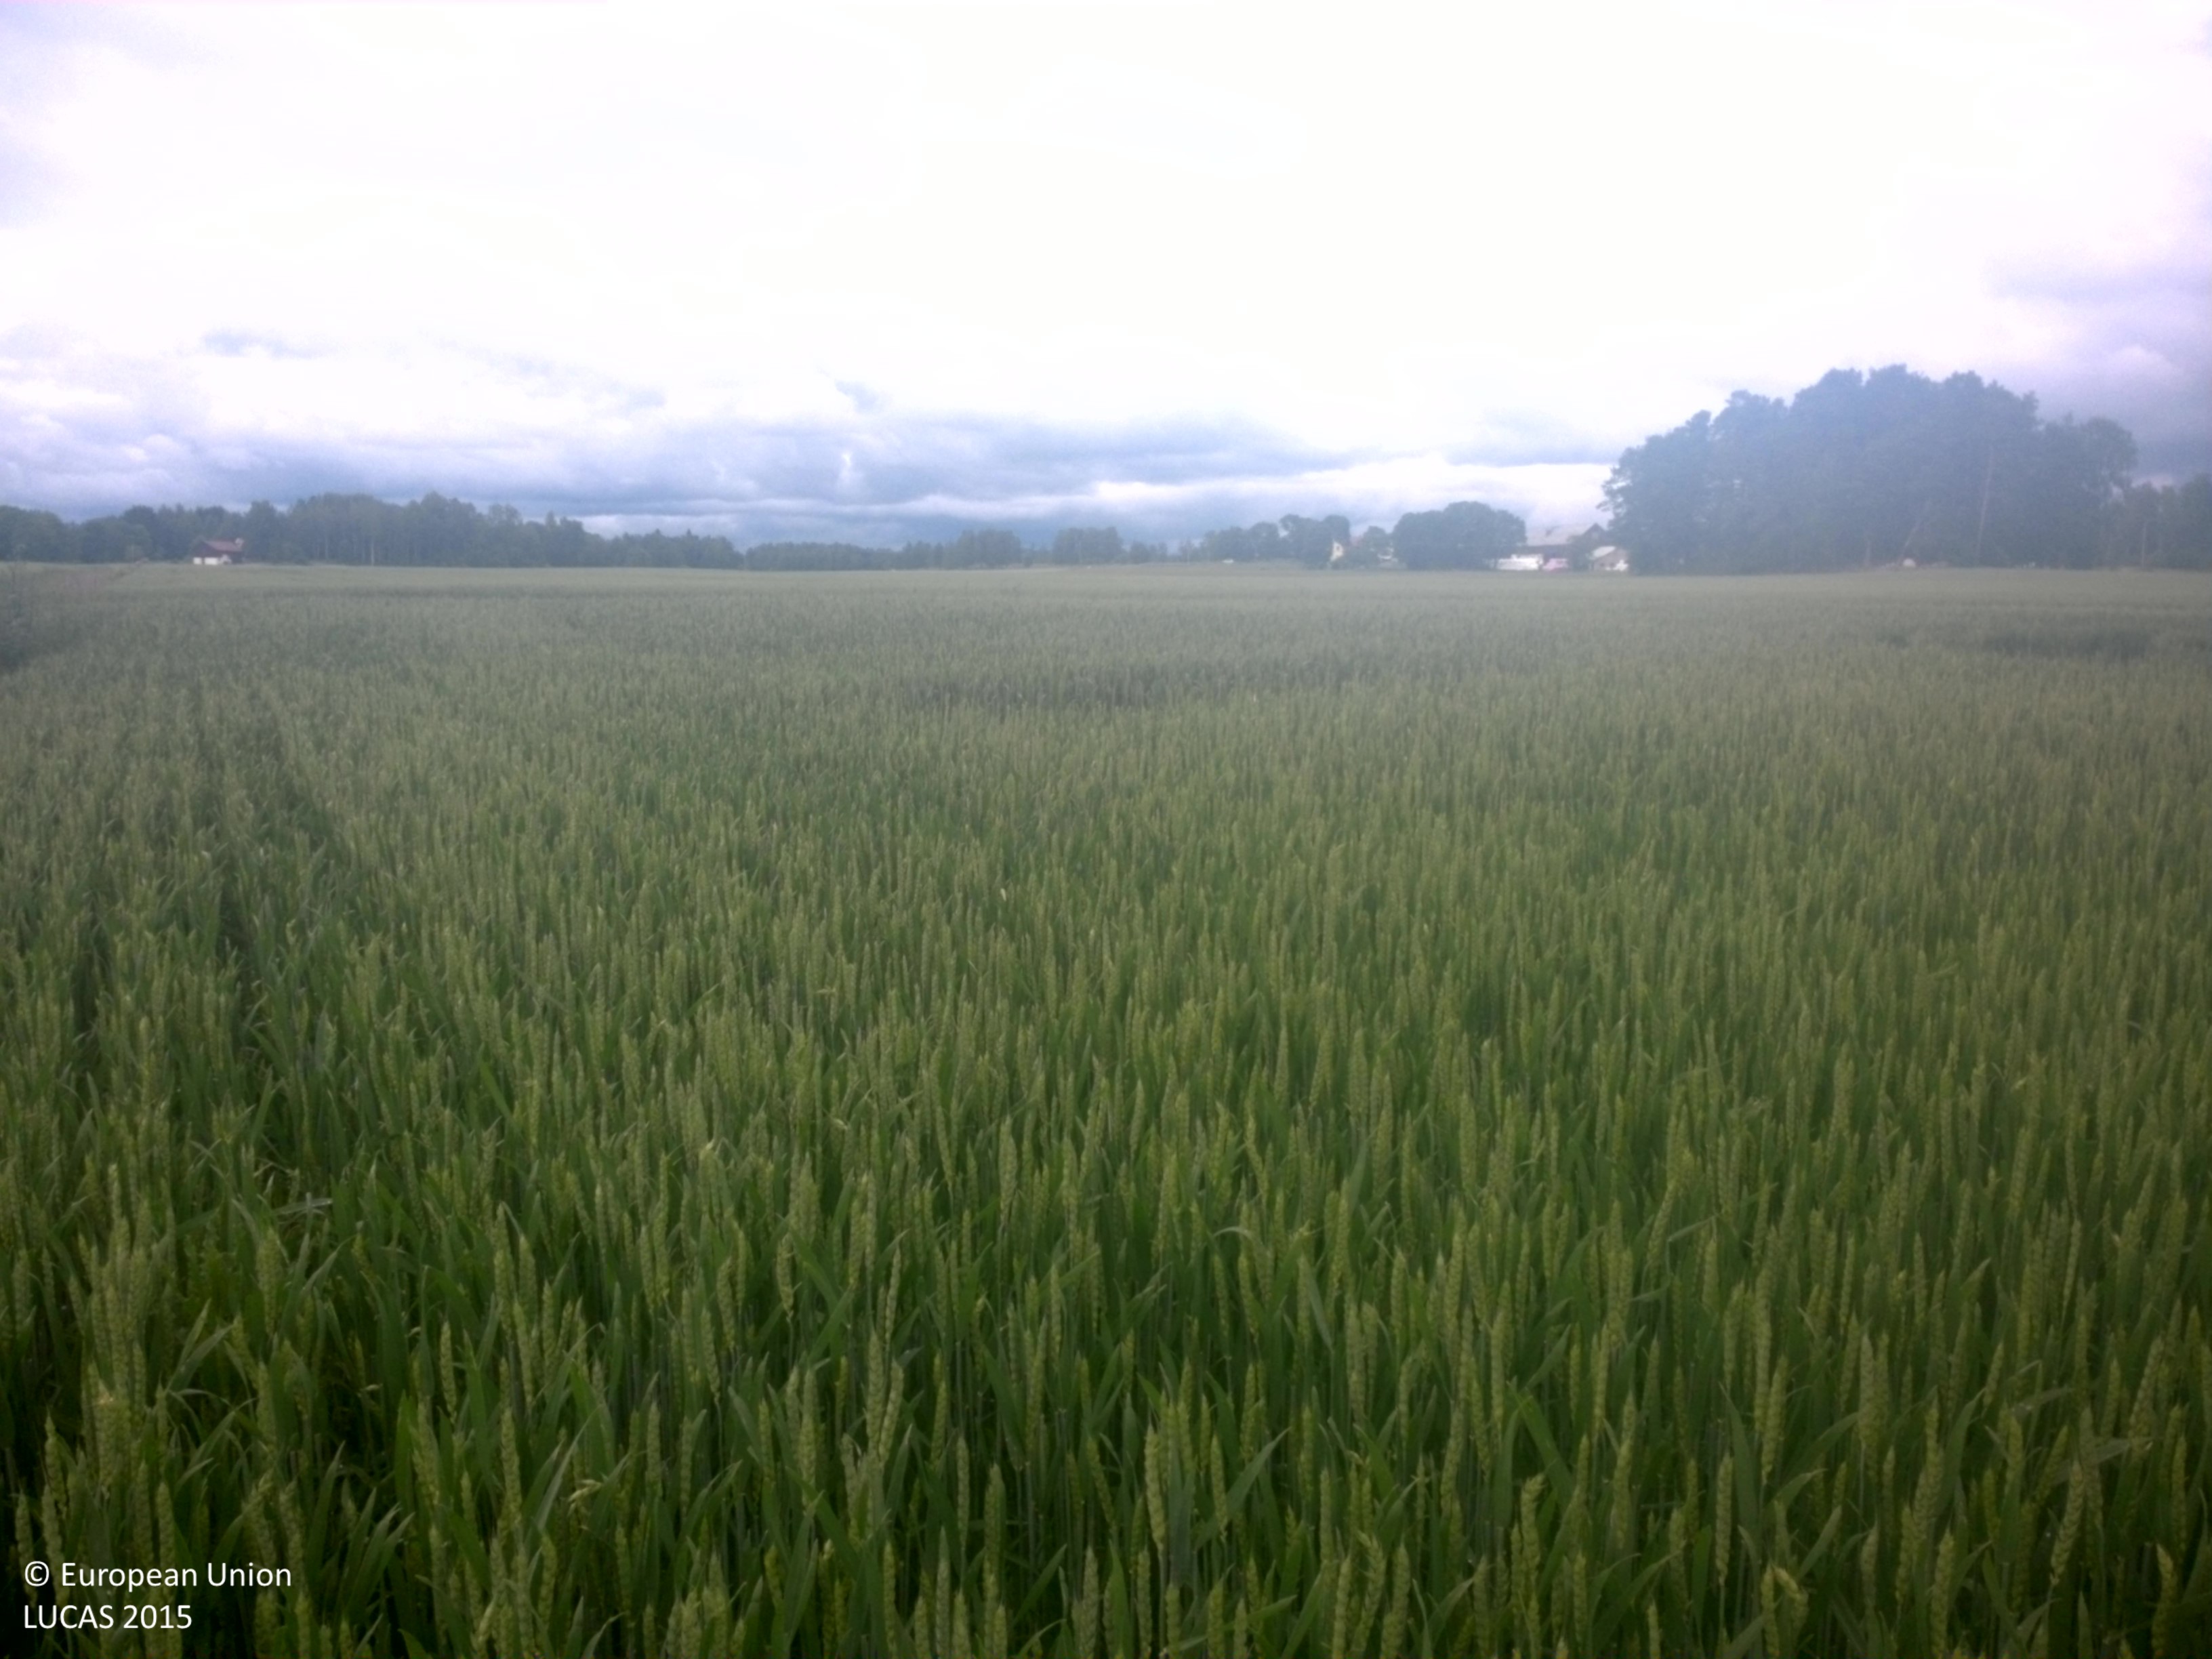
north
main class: Cropland
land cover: Common wheat
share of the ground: > 75 %
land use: Agriculture (excluding fallow land and kitchen gardens)
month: July
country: SE
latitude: 60.1032
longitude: 17.2403
